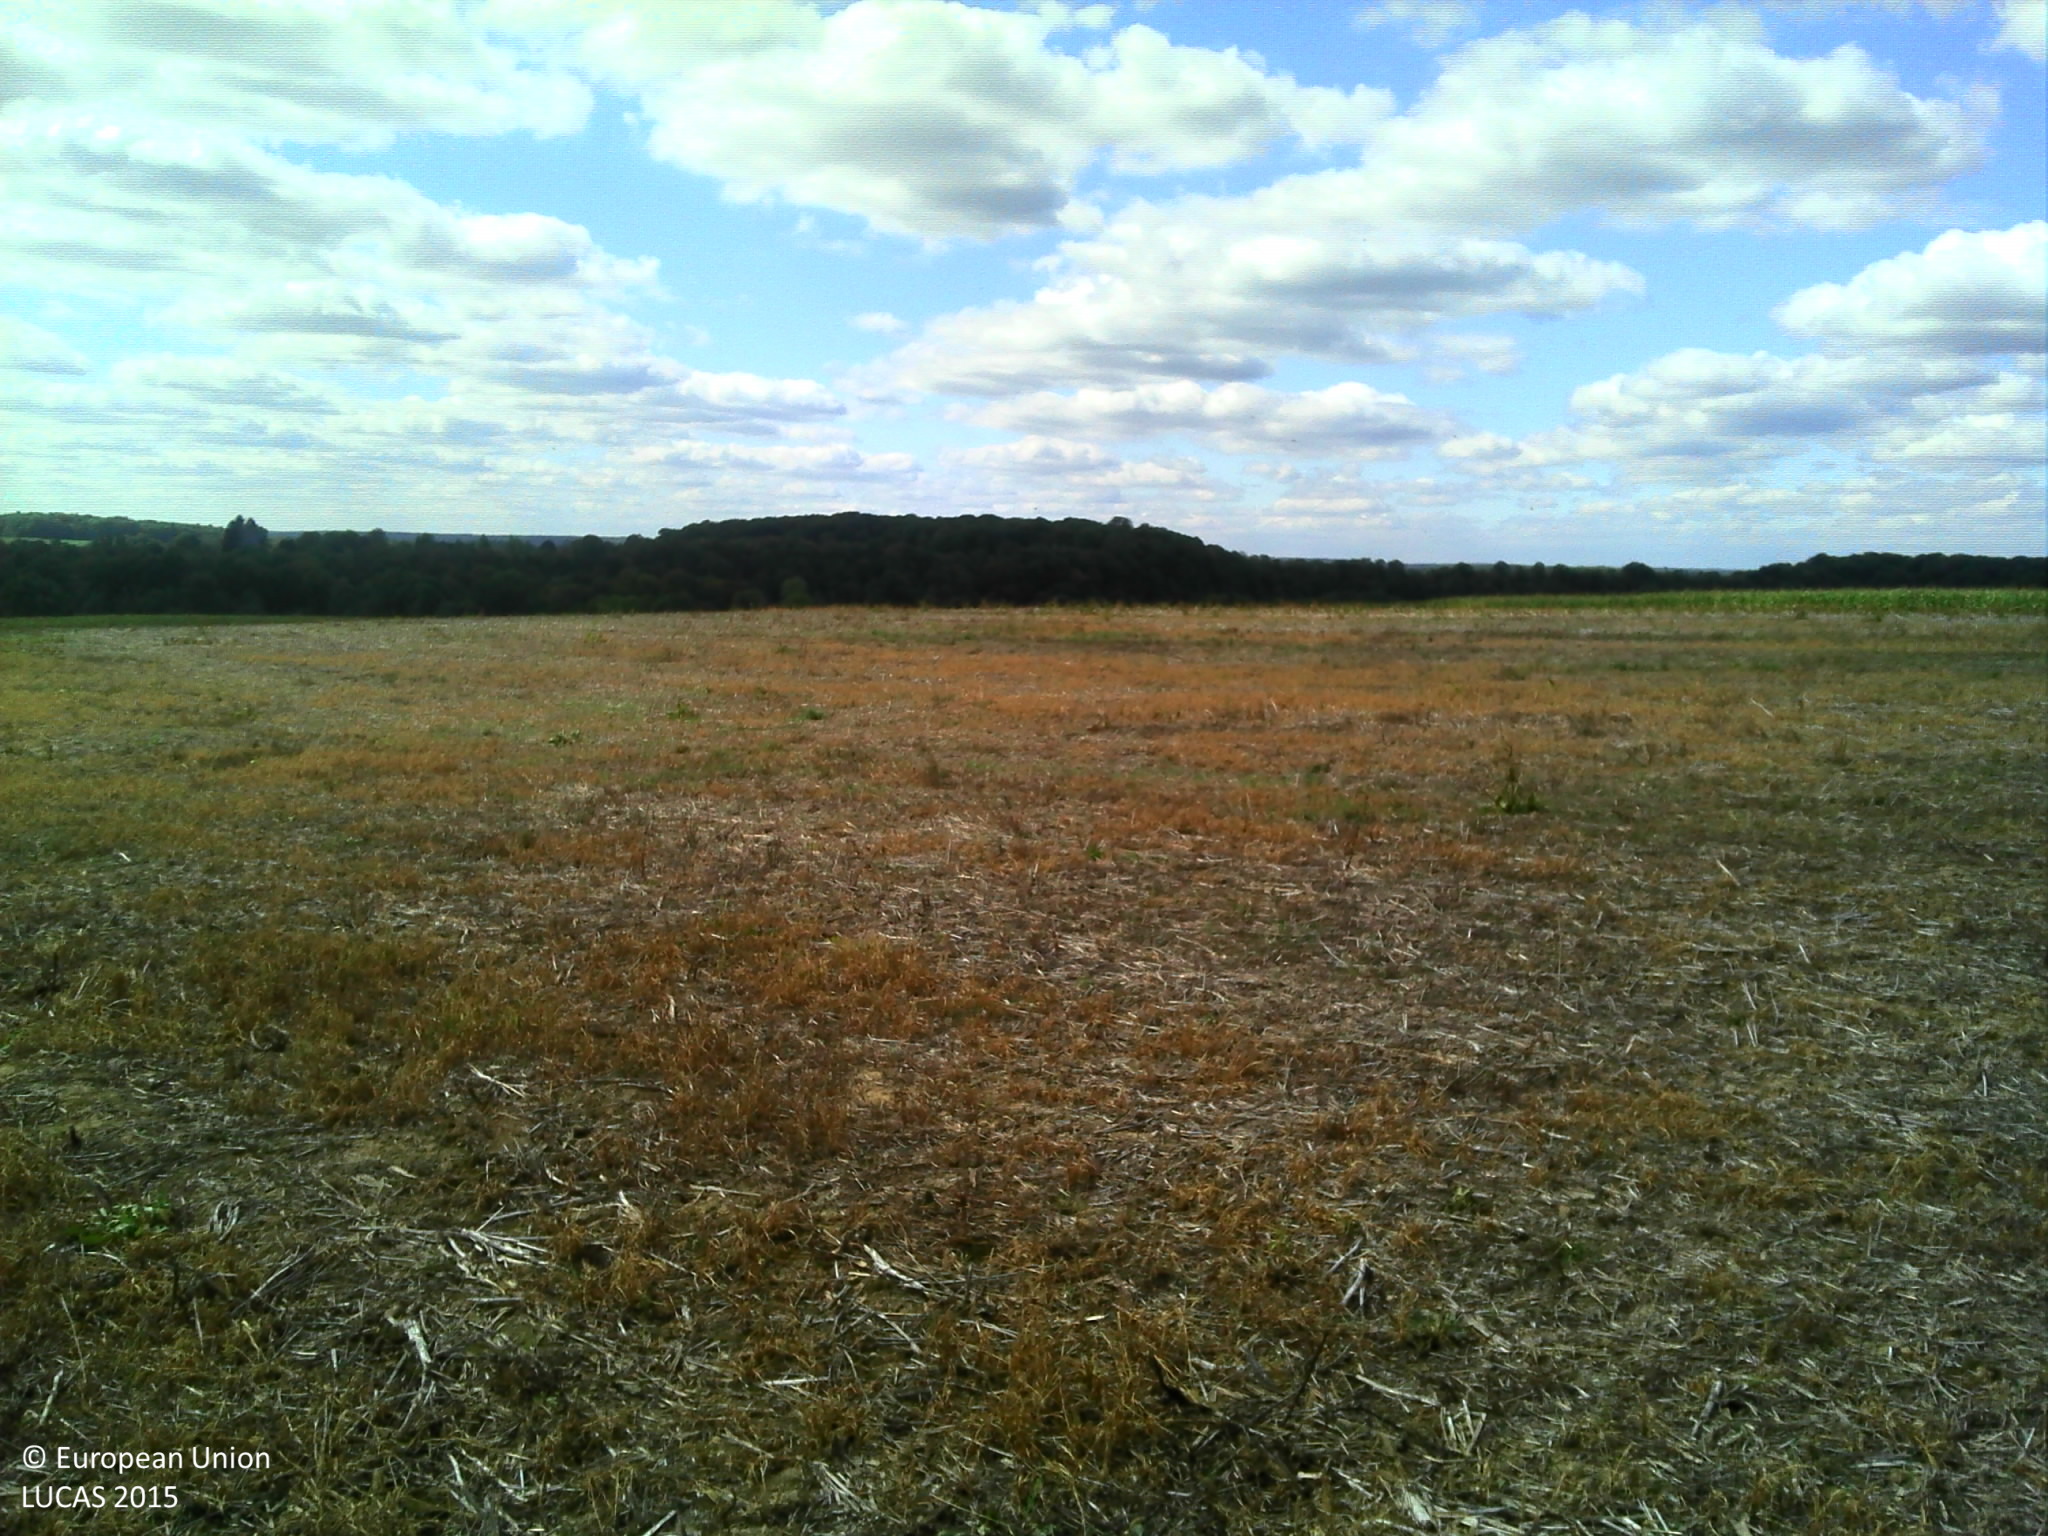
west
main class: Grassland
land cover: Spontaneously vegetated surfaces
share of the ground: > 75 %
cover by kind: herbaceous plants 80 %, unconsolidated bare surface 20 %
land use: Agriculture (excluding fallow land and kitchen gardens)
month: September
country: FR
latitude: 47.4211
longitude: 6.2503
